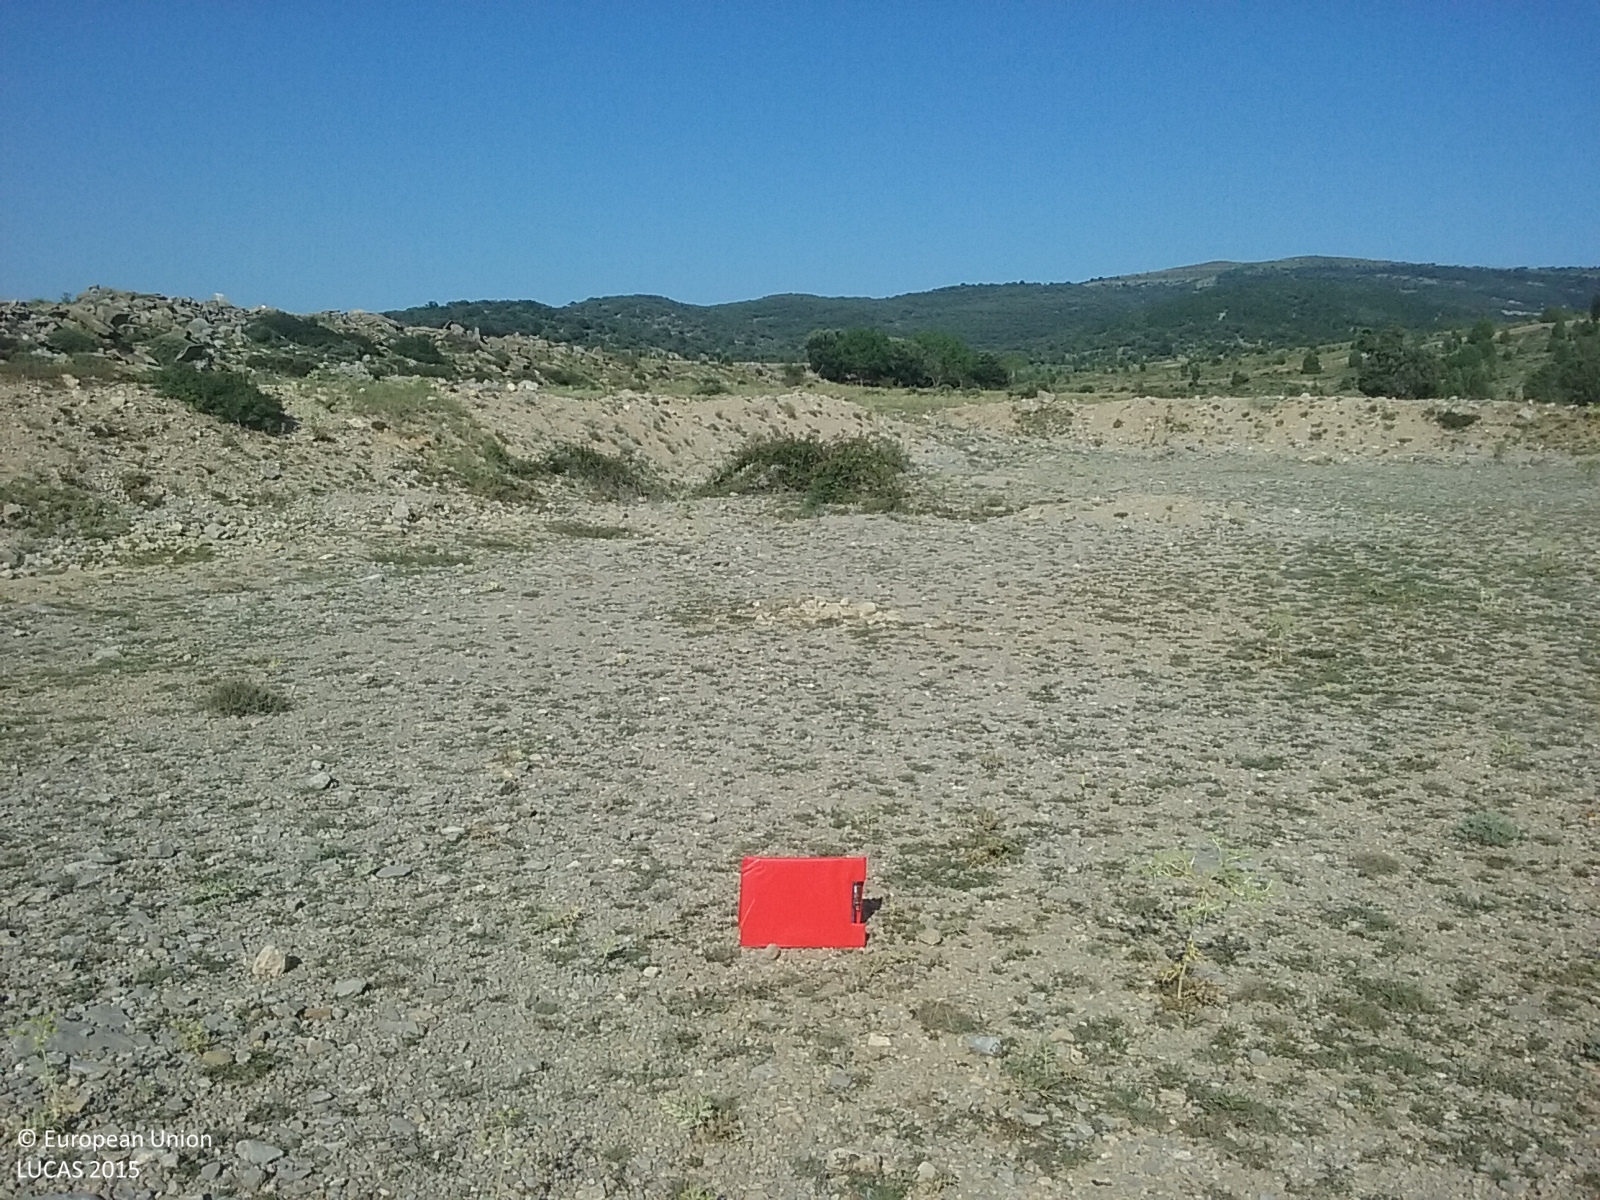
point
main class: Grassland
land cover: Grassland without tree/shrub cover
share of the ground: 10 - 25 %
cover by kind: consolidated bare surface 80 %, herbaceous plants 20 %
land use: Agriculture (excluding fallow land and kitchen gardens)
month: August
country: ES
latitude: 40.5437
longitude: -0.1257
